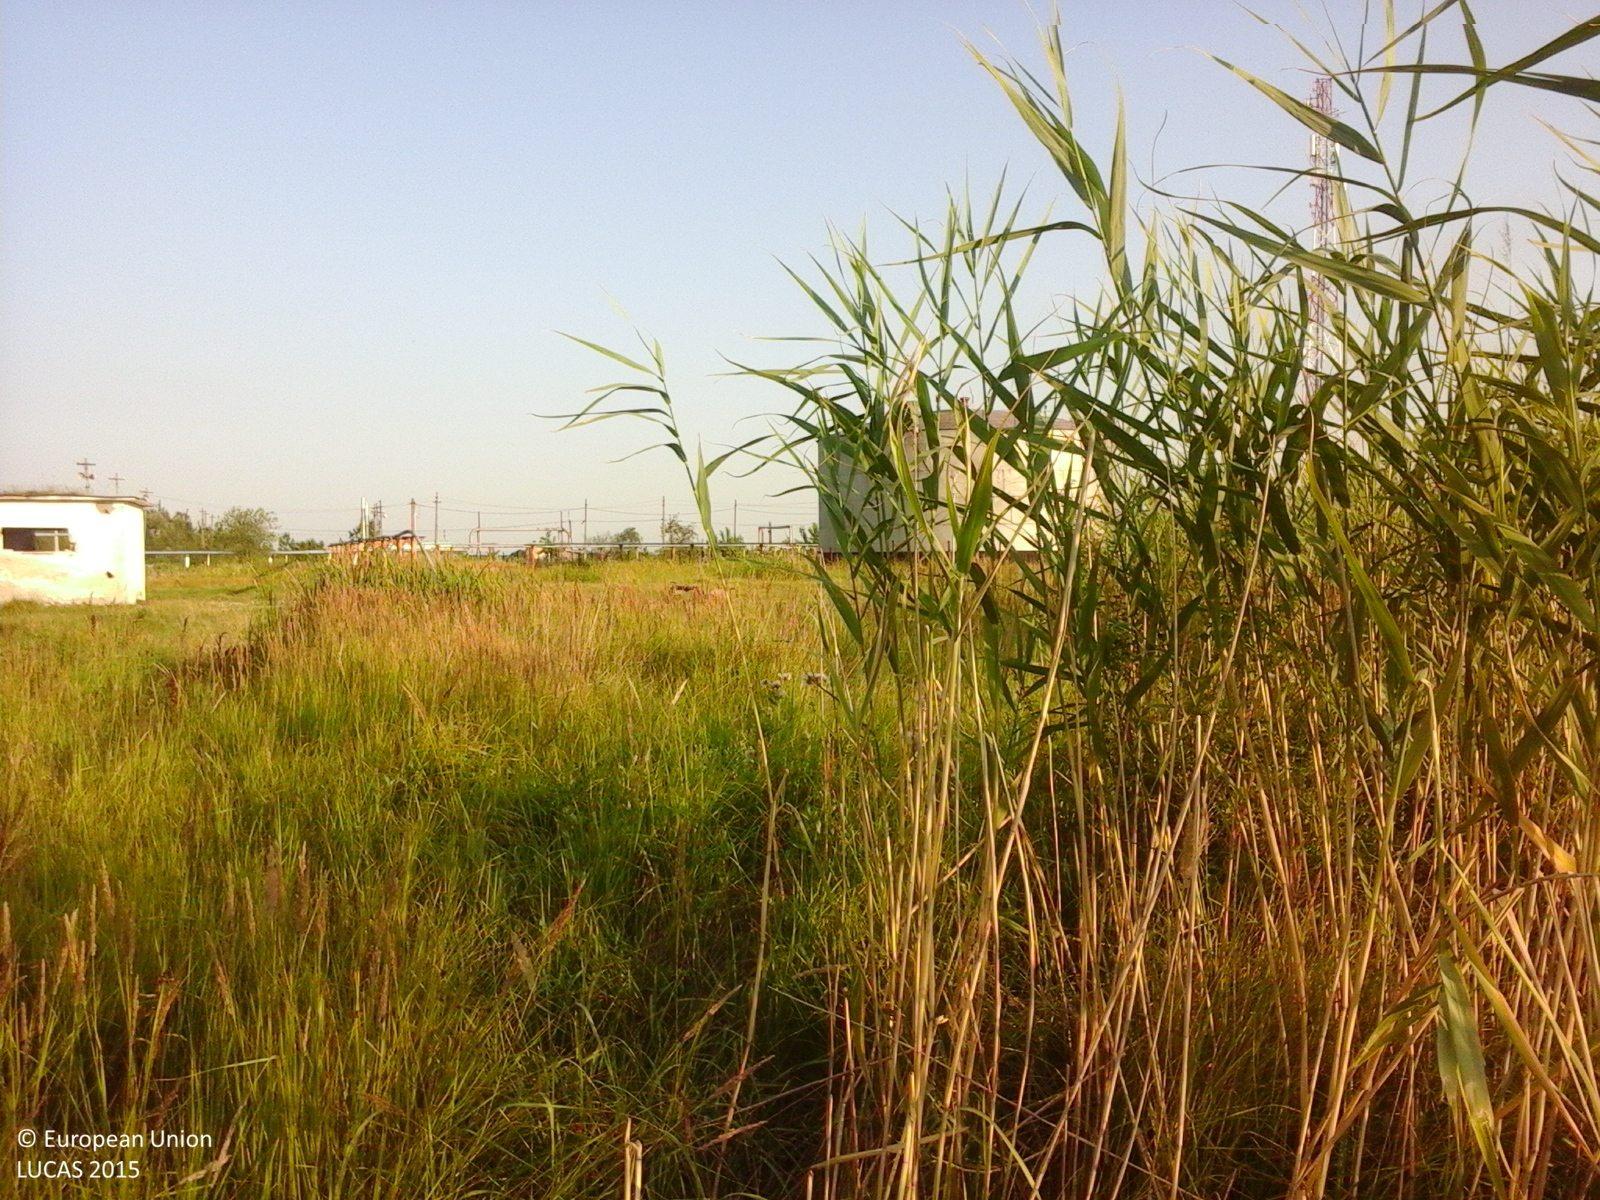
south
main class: Grassland
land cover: Spontaneously vegetated surfaces
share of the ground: > 75 %
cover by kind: herbaceous plants 100 %
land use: Semi-natural and natural areas not in use
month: July
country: RO
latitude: 44.4130
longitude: 24.7047
